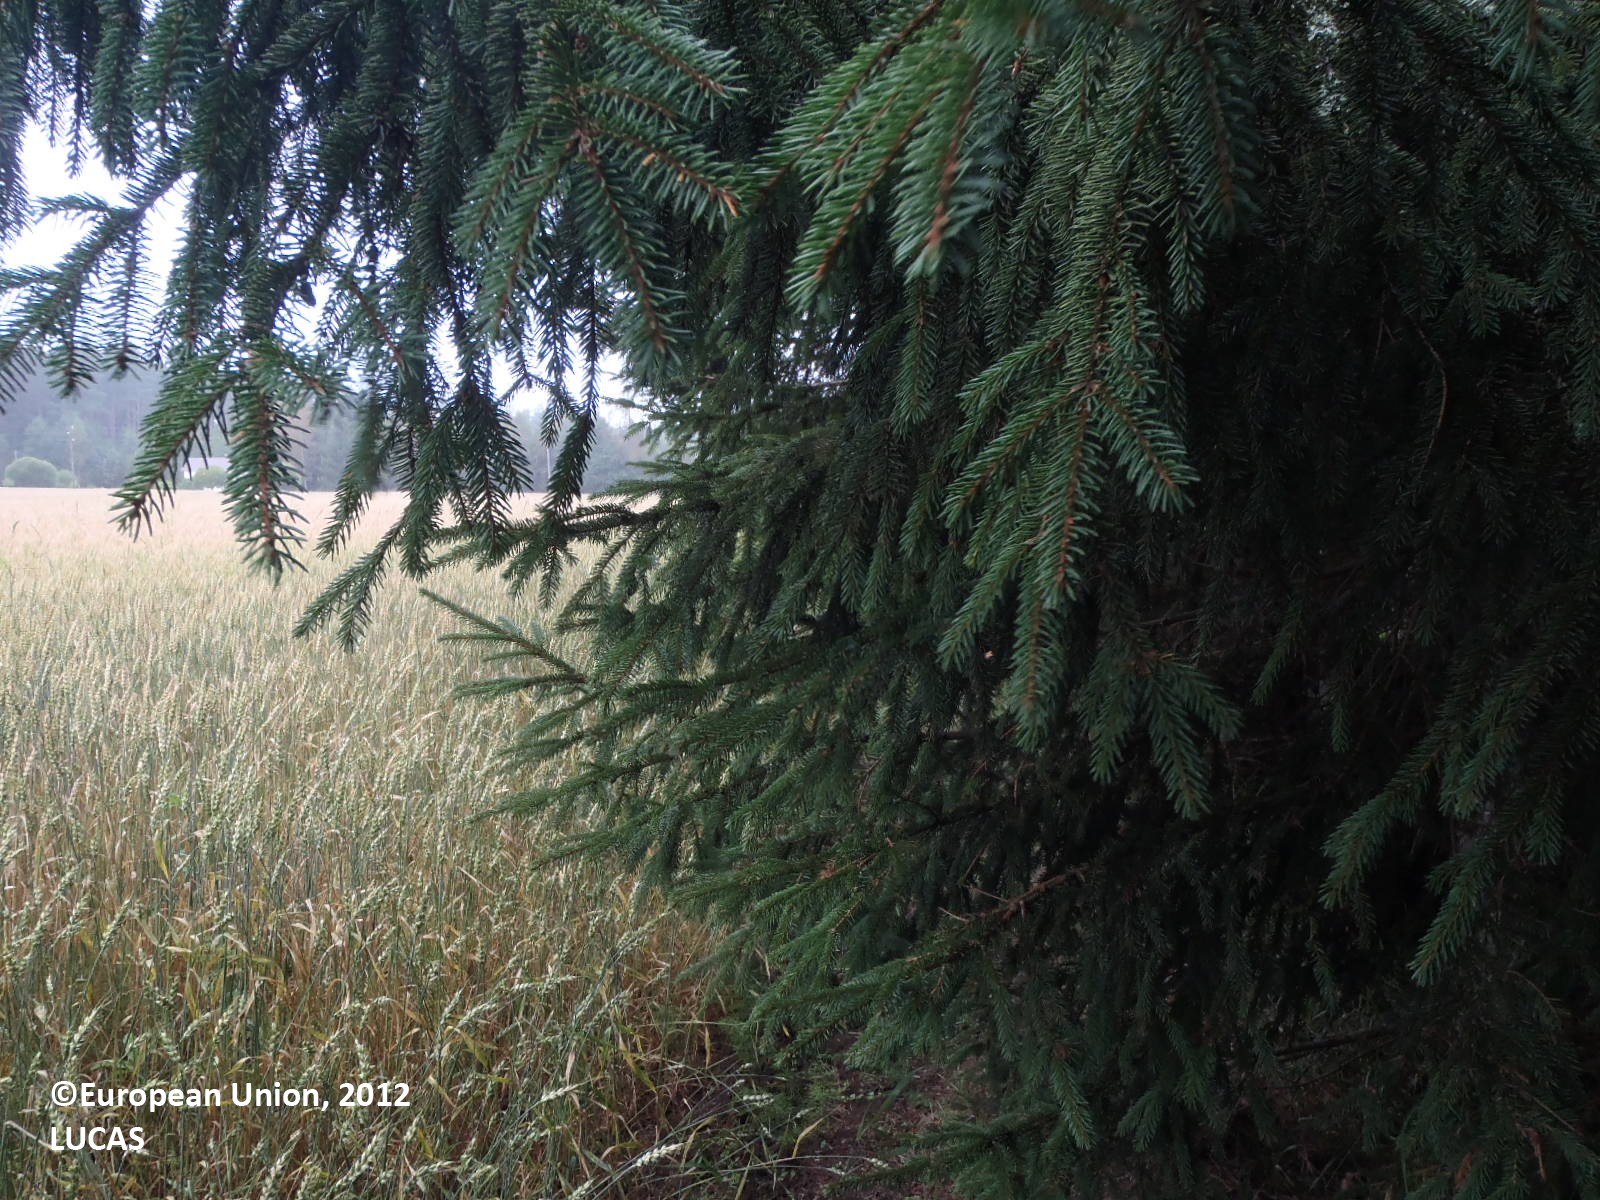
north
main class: Woodland
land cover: Spruce dominated mixed woodland
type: boreal forest
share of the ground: > 75 %
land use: Forestry
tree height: > 5 m
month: August
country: FI
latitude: 60.6886
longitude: 22.2056
